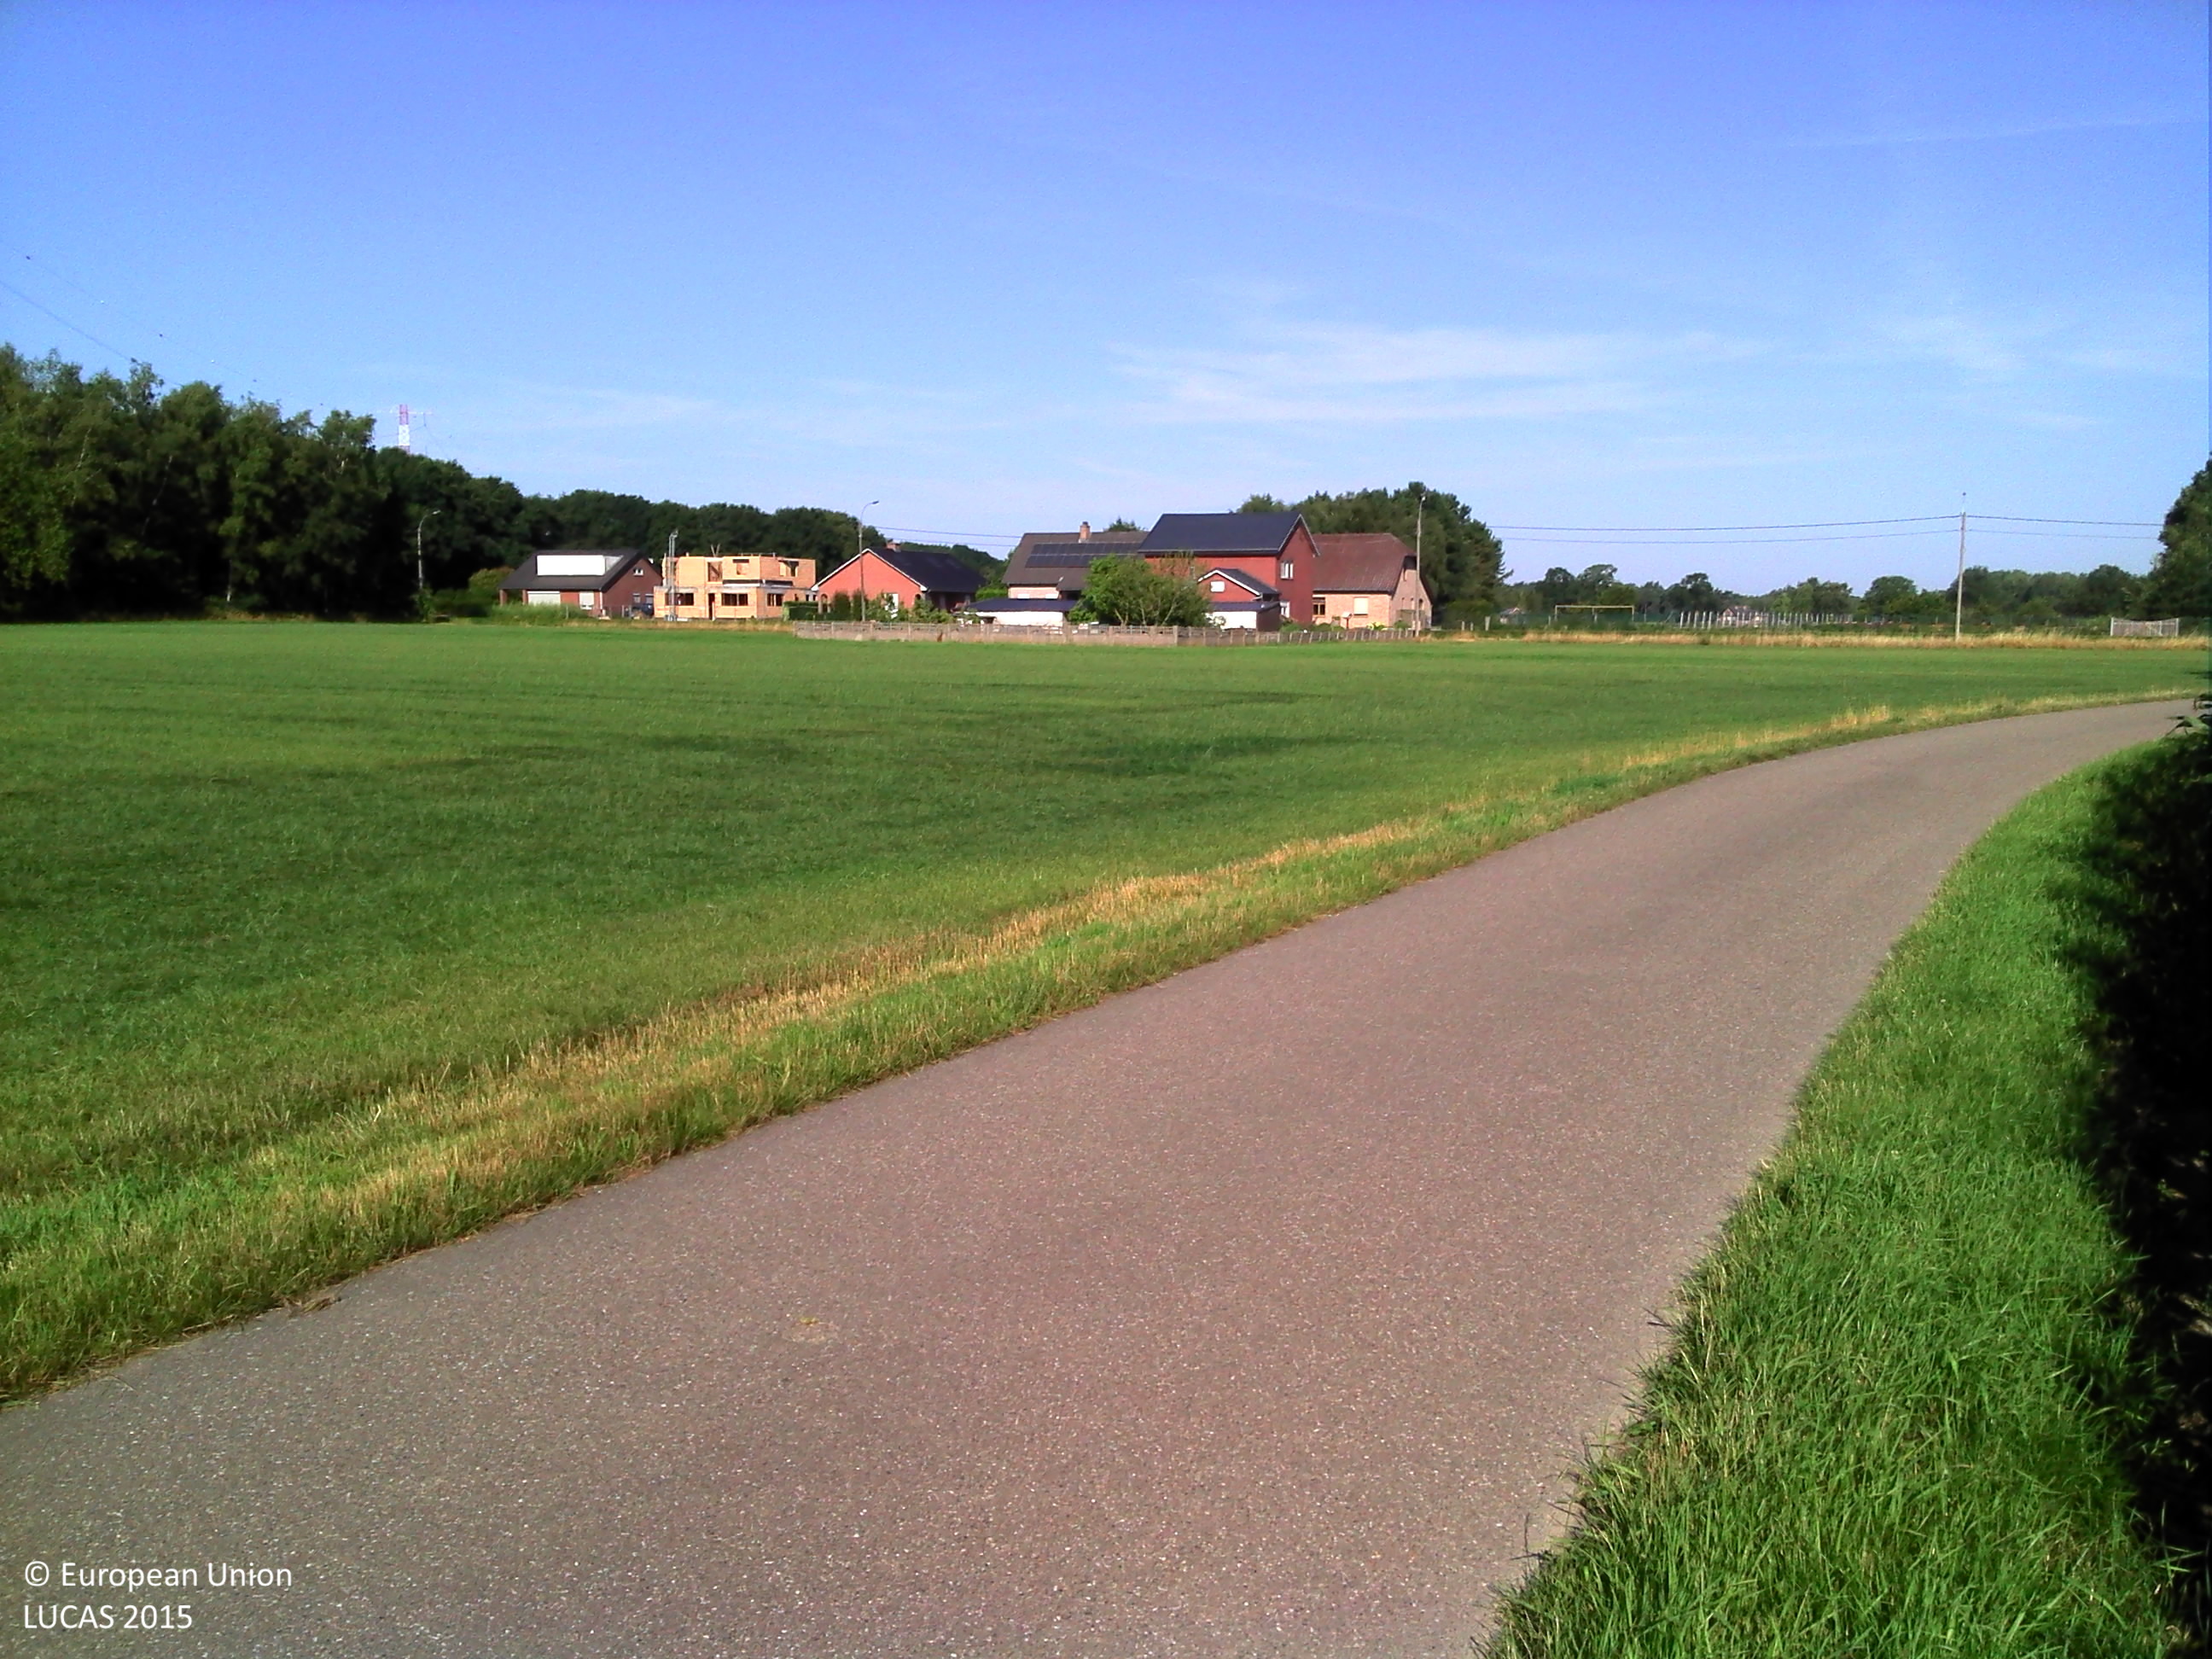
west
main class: Cropland
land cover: Maize
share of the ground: > 75 %
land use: Agriculture (excluding fallow land and kitchen gardens)
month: August
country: BE
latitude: 51.1420
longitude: 5.5530
